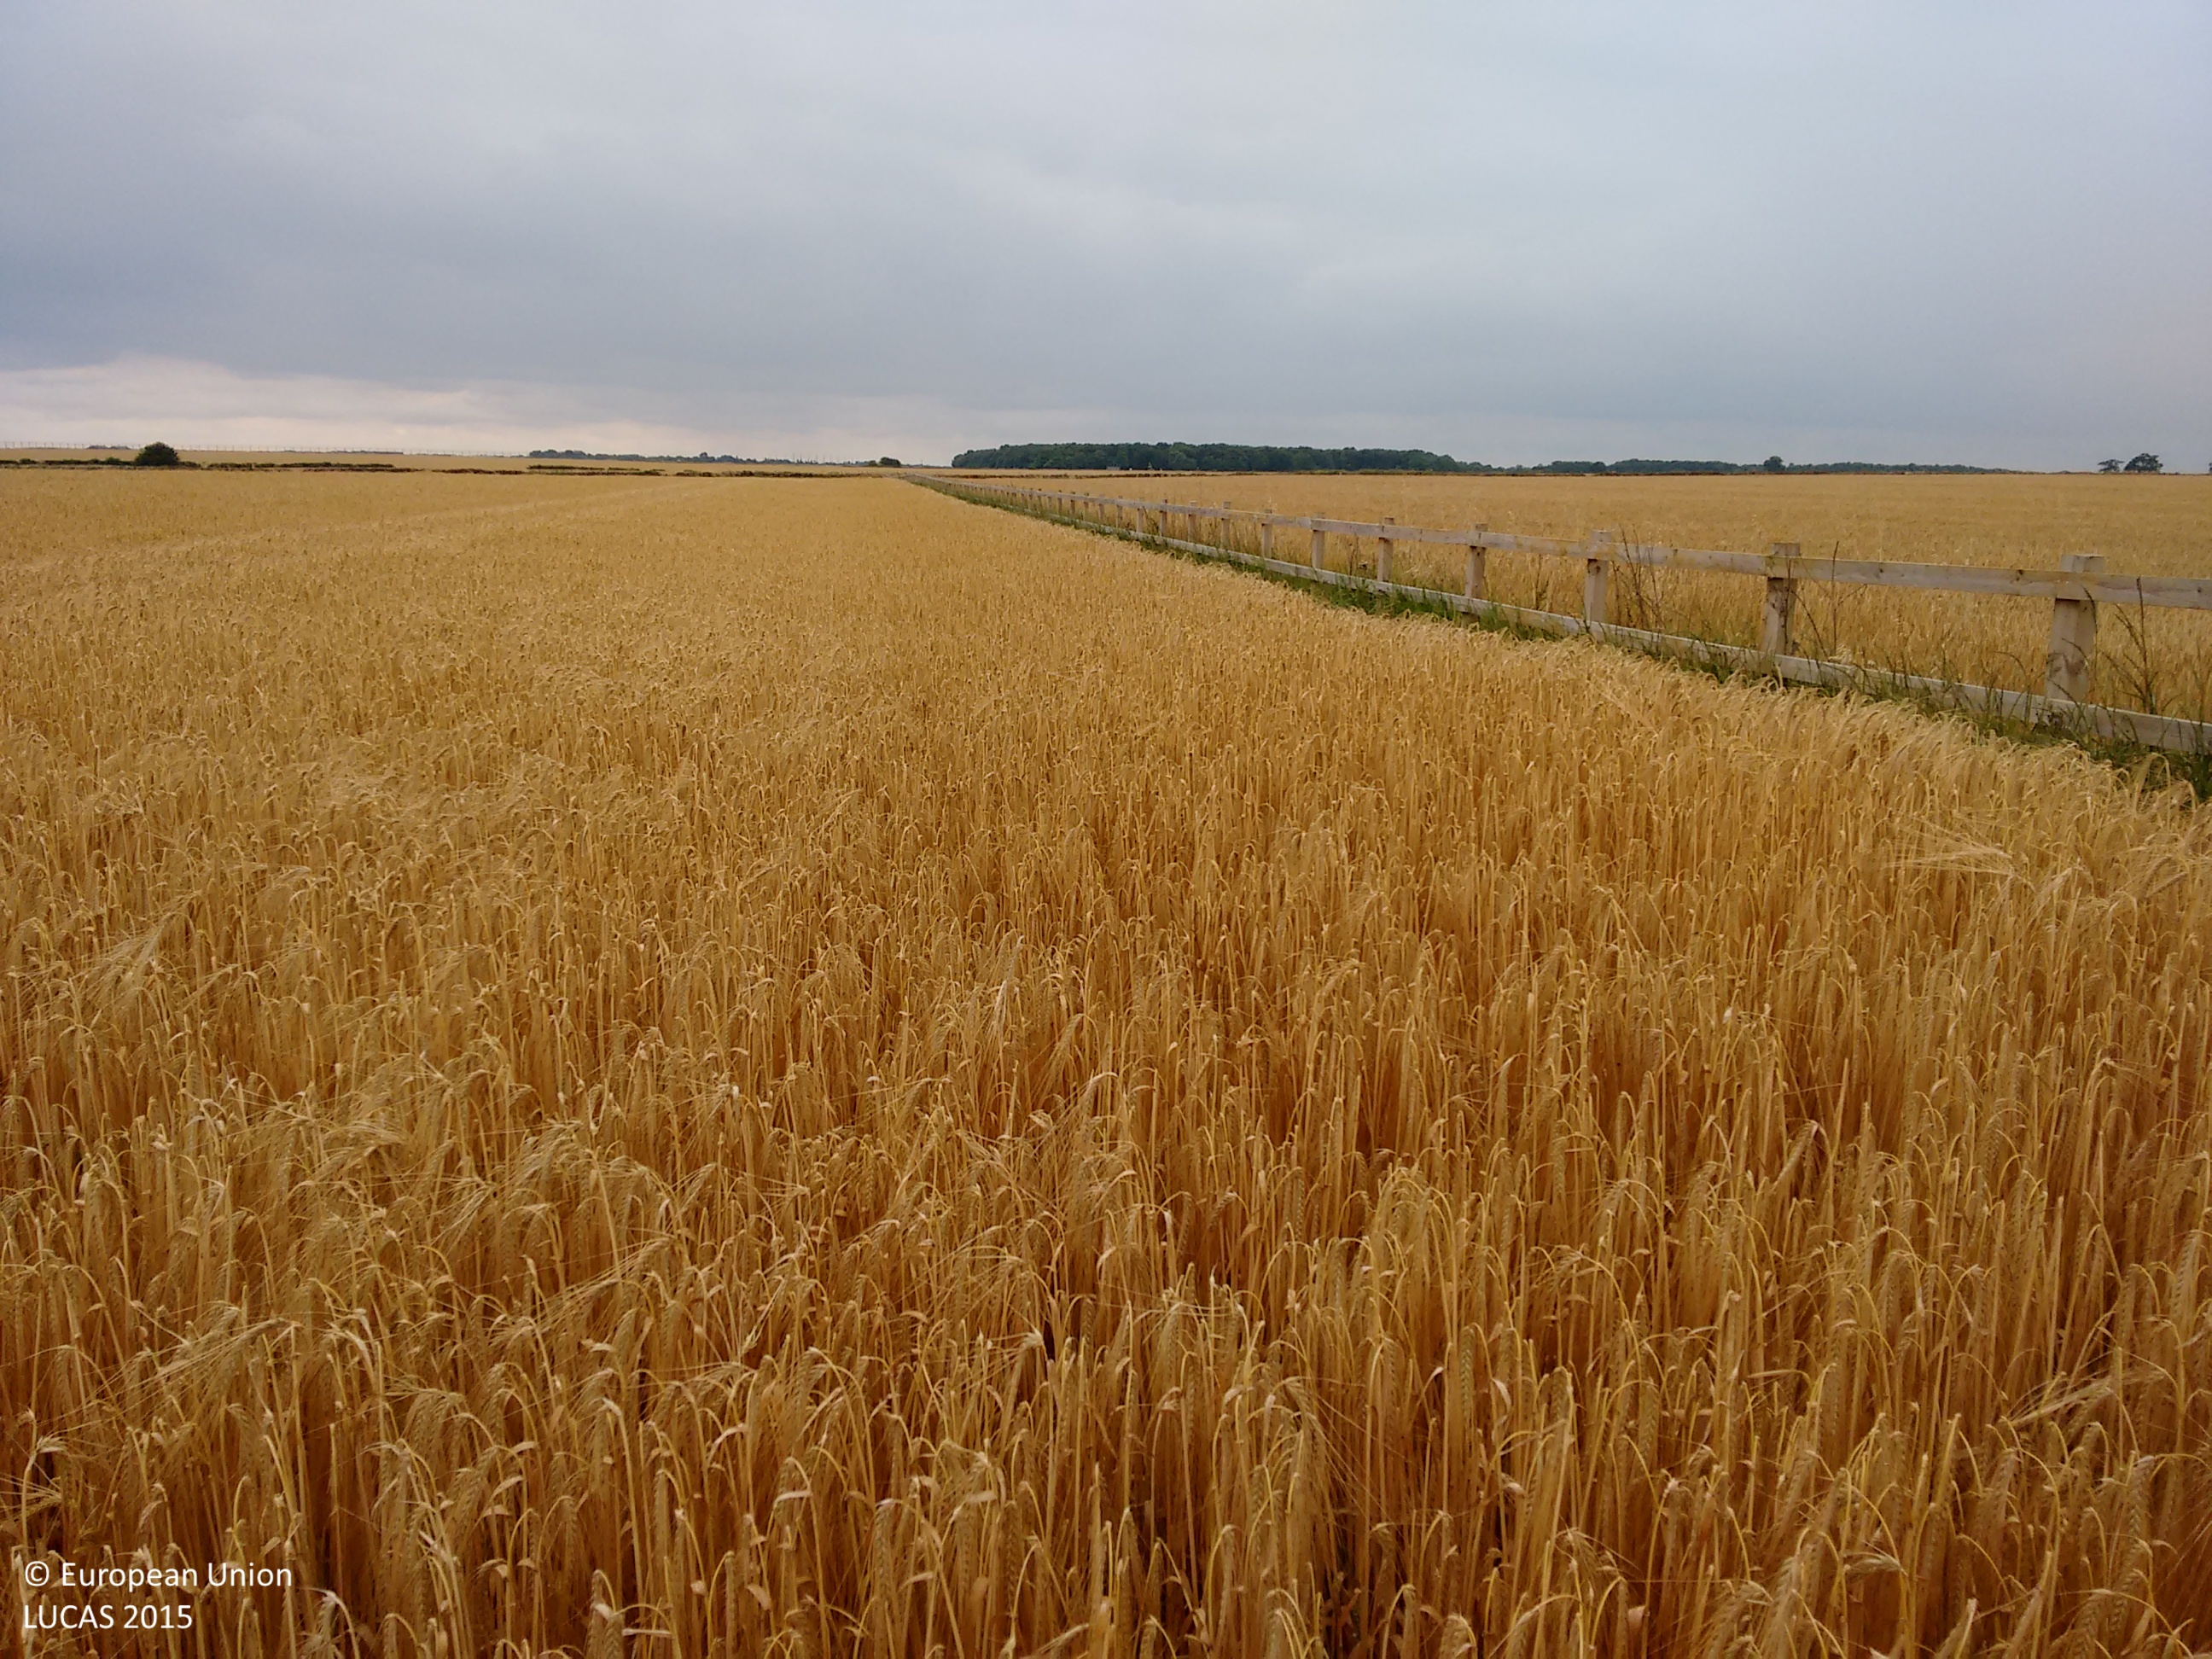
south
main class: Cropland
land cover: Barley
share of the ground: > 75 %
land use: Agriculture (excluding fallow land and kitchen gardens)
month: July
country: GB
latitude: 52.6168
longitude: -0.5101
